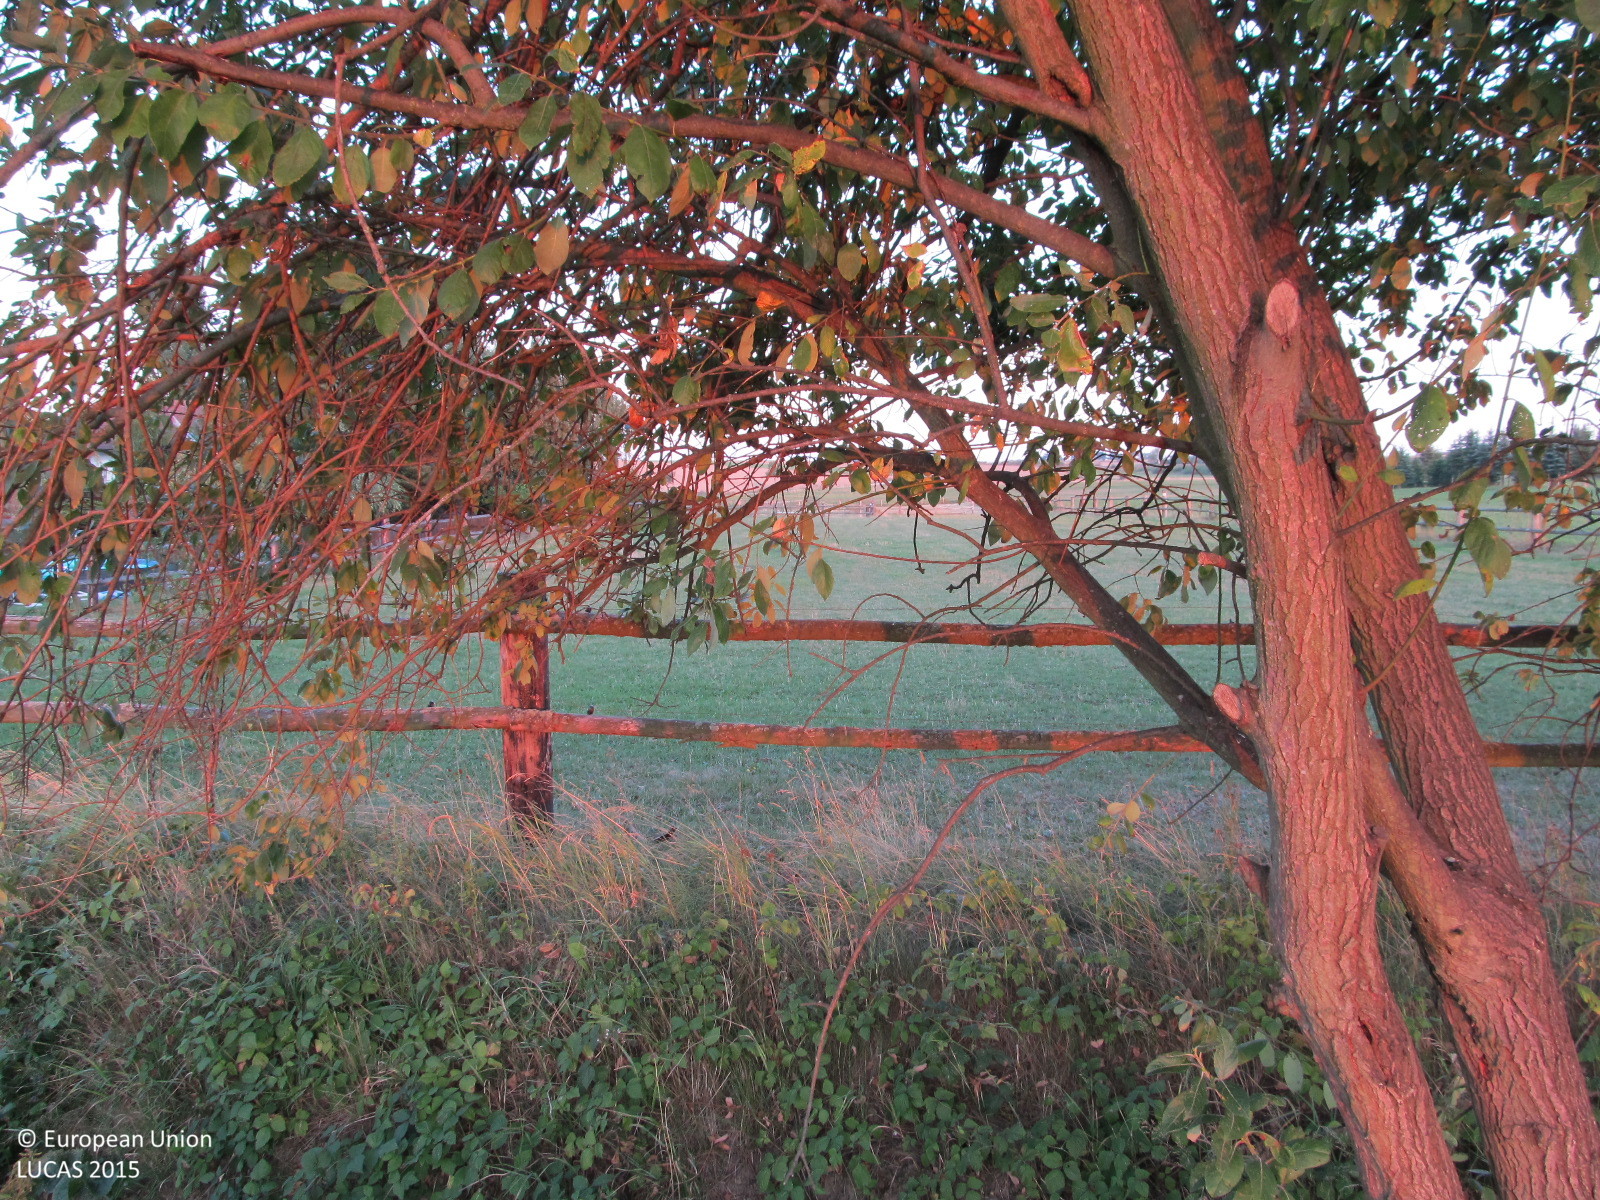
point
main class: Grassland
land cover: Grassland without tree/shrub cover
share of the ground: > 75 %
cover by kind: herbaceous plants 100 %
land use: Agriculture (excluding fallow land and kitchen gardens)
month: August
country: AT
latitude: 48.7556
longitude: 15.4575
